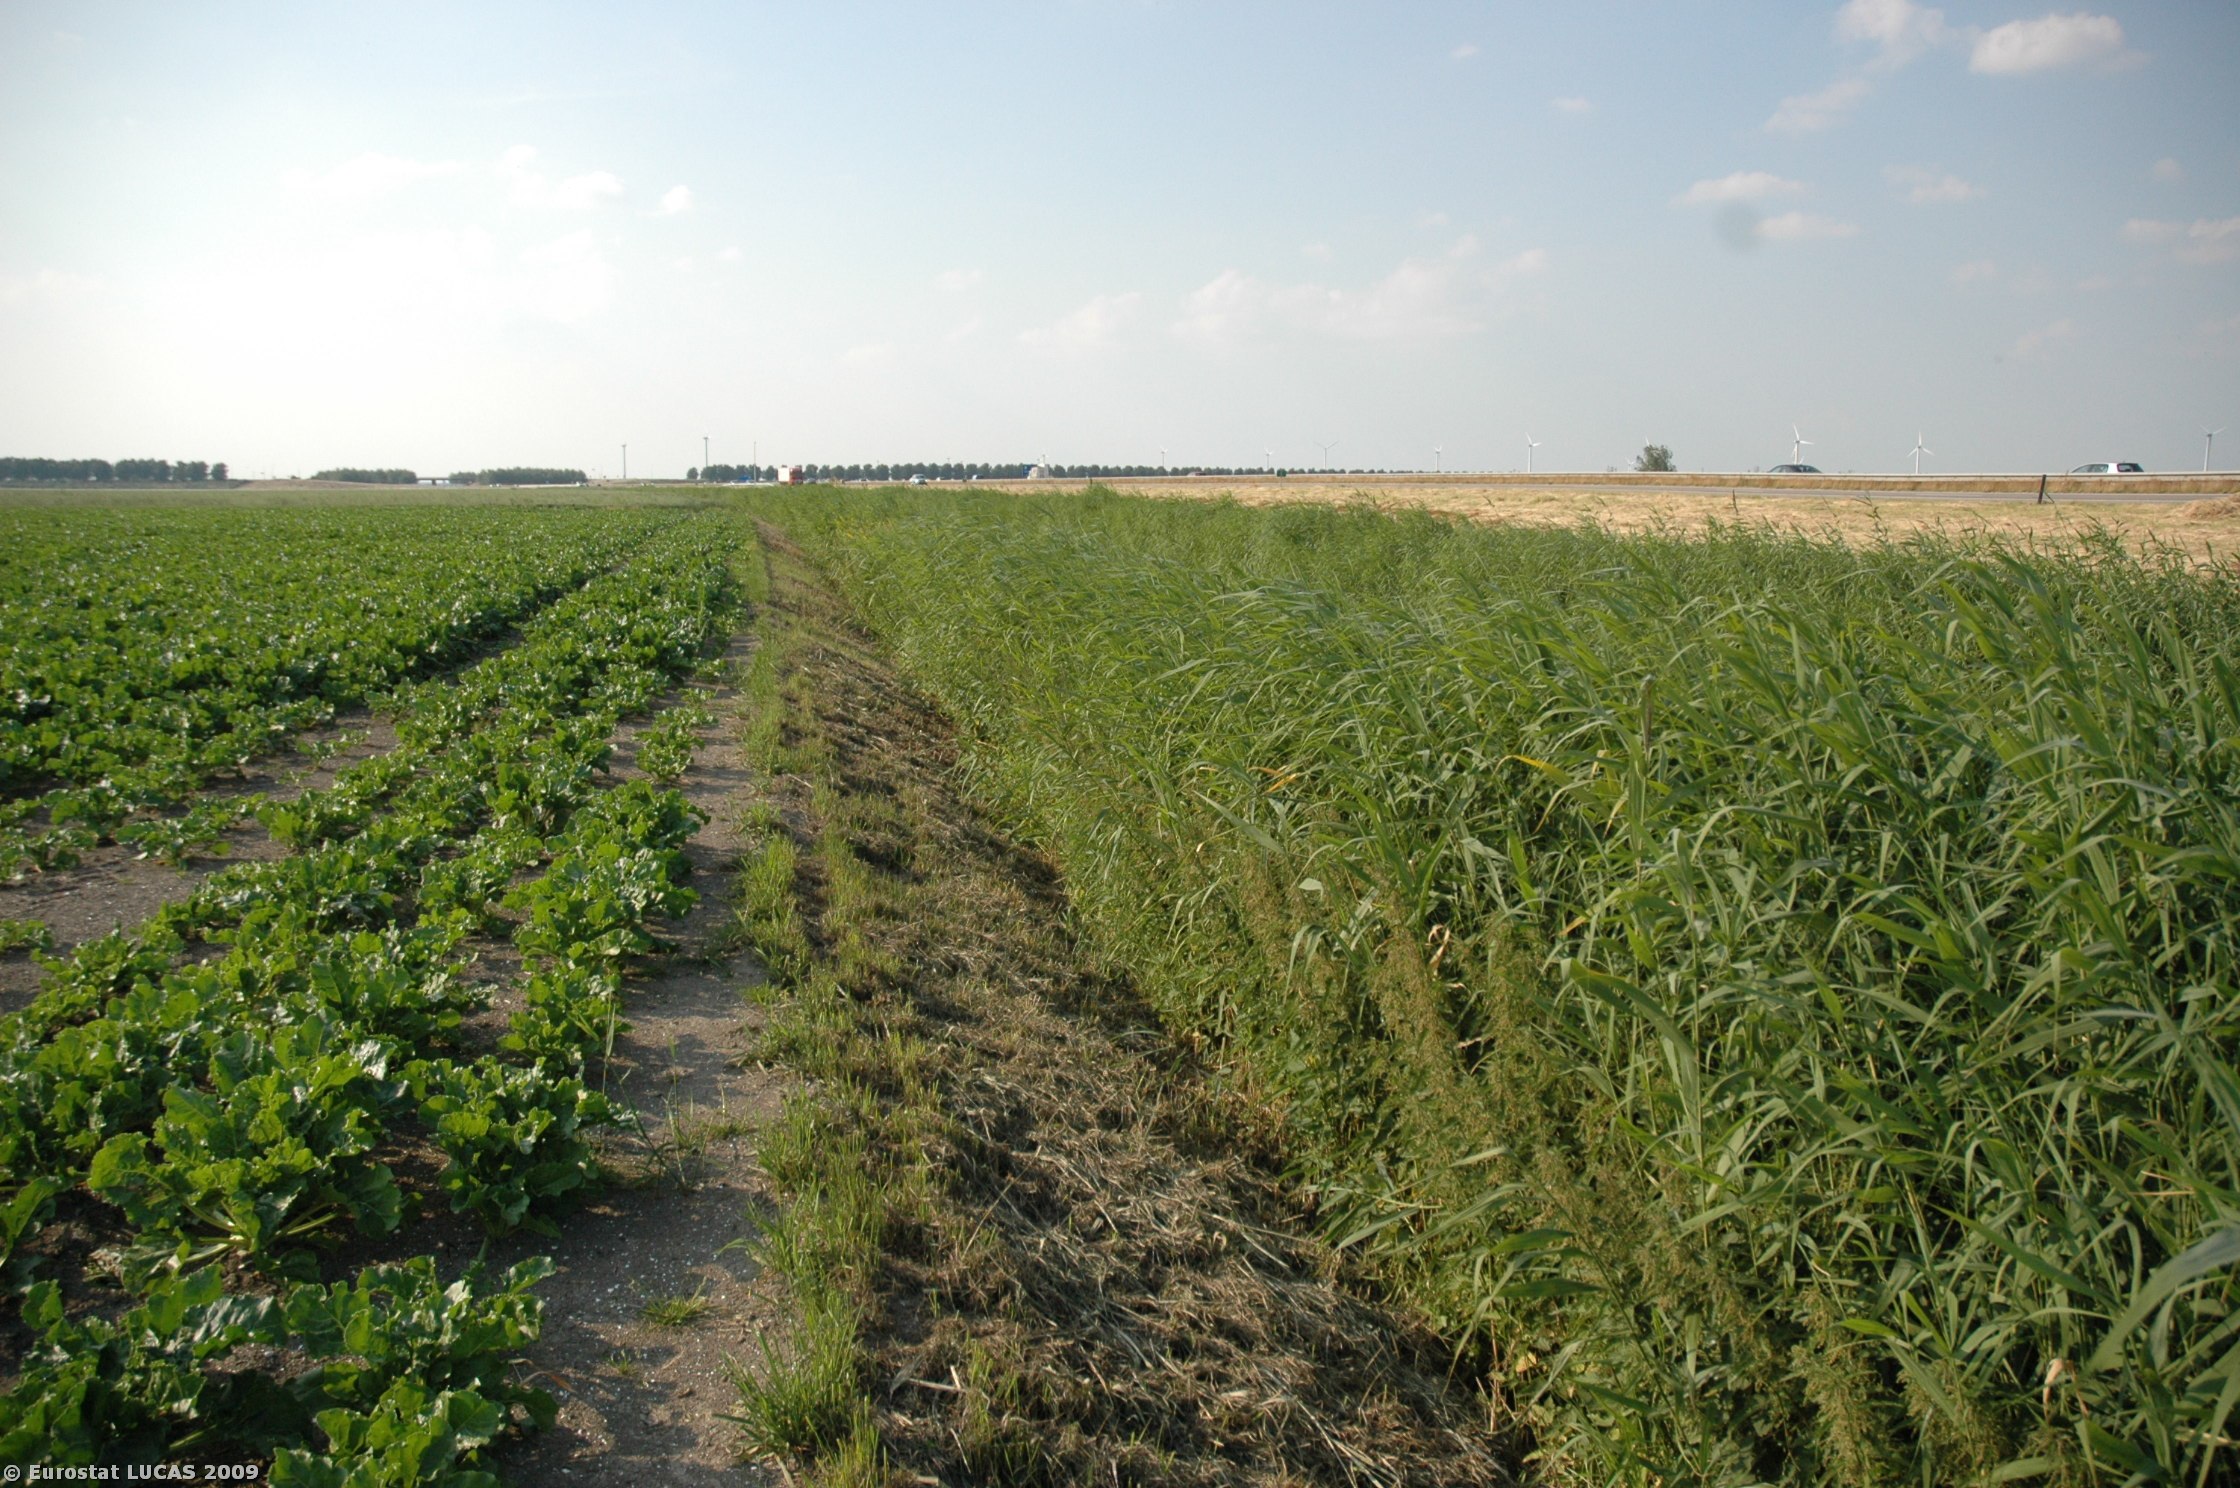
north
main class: Grassland
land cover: Grassland without tree/shrub cover
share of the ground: > 75 %
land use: Agriculture (excluding fallow land and kitchen gardens)
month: June
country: NL
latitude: 52.3403
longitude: 5.3453
